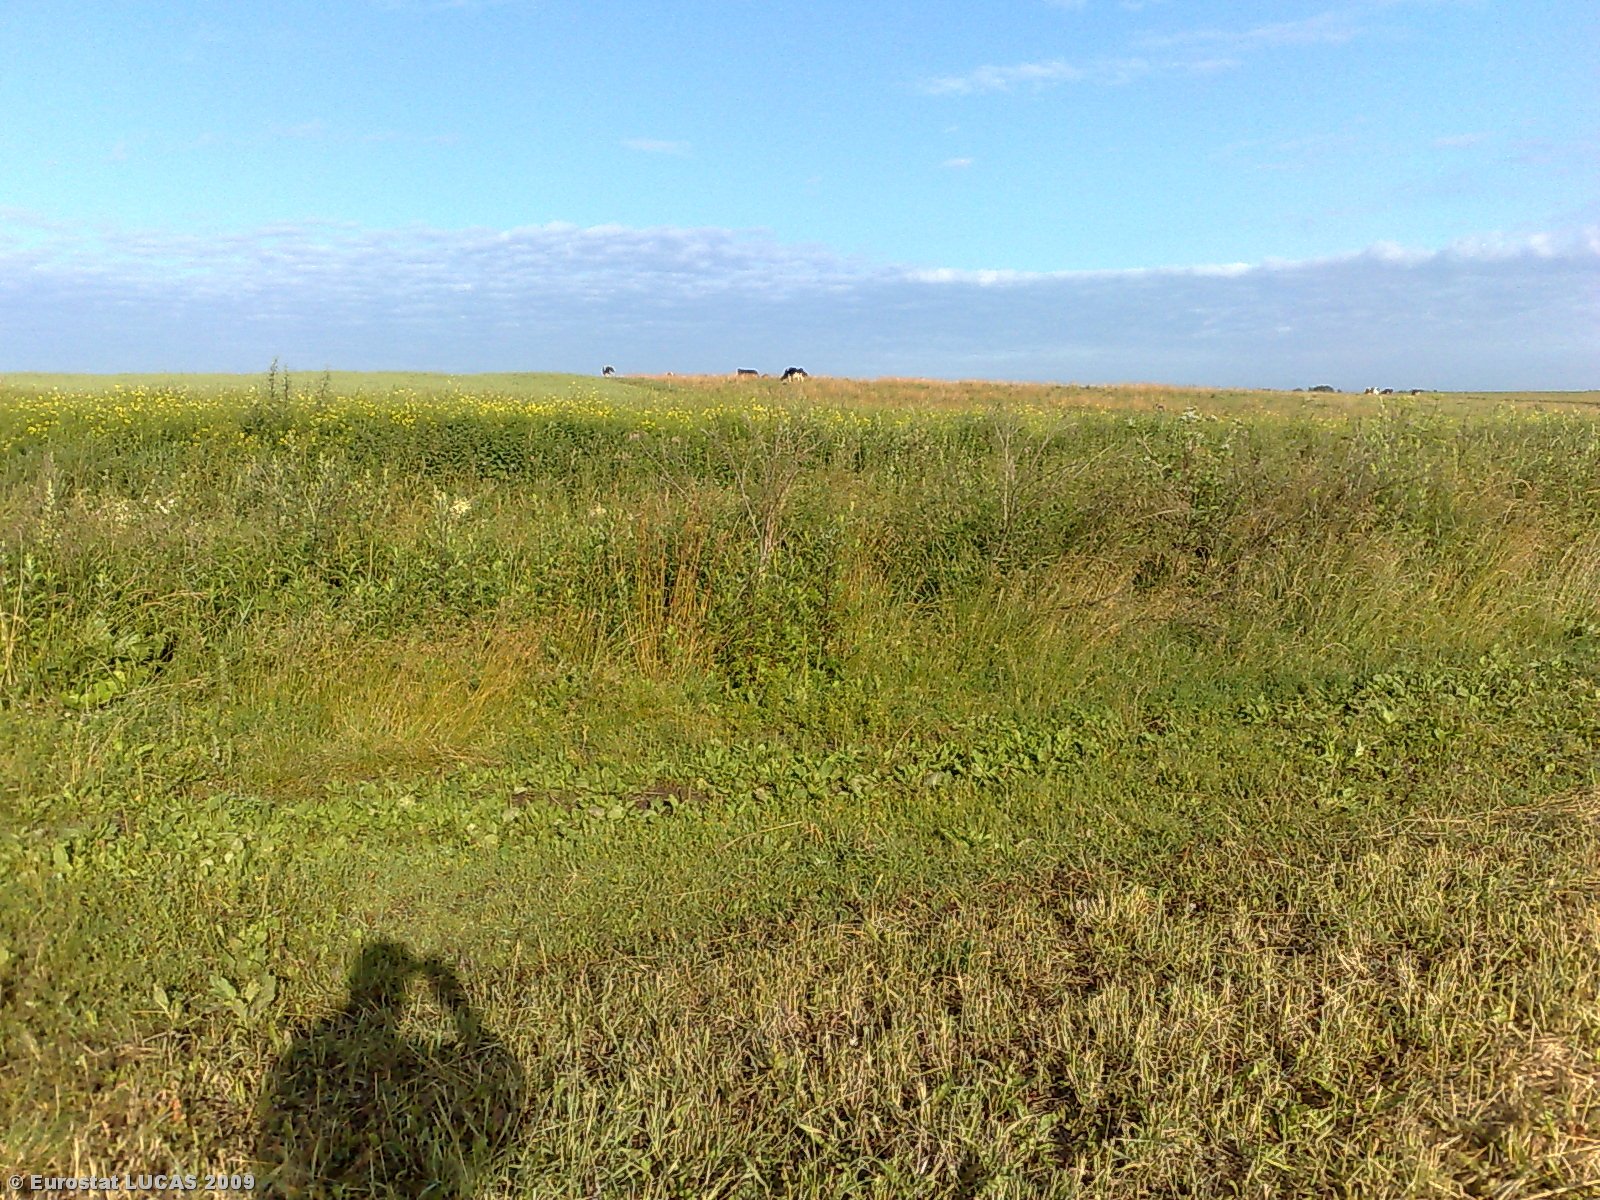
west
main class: Grassland
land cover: Grassland without tree/shrub cover
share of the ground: > 75 %
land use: Agriculture (excluding fallow land and kitchen gardens)
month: July
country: LT
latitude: 55.6708
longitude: 22.8012
